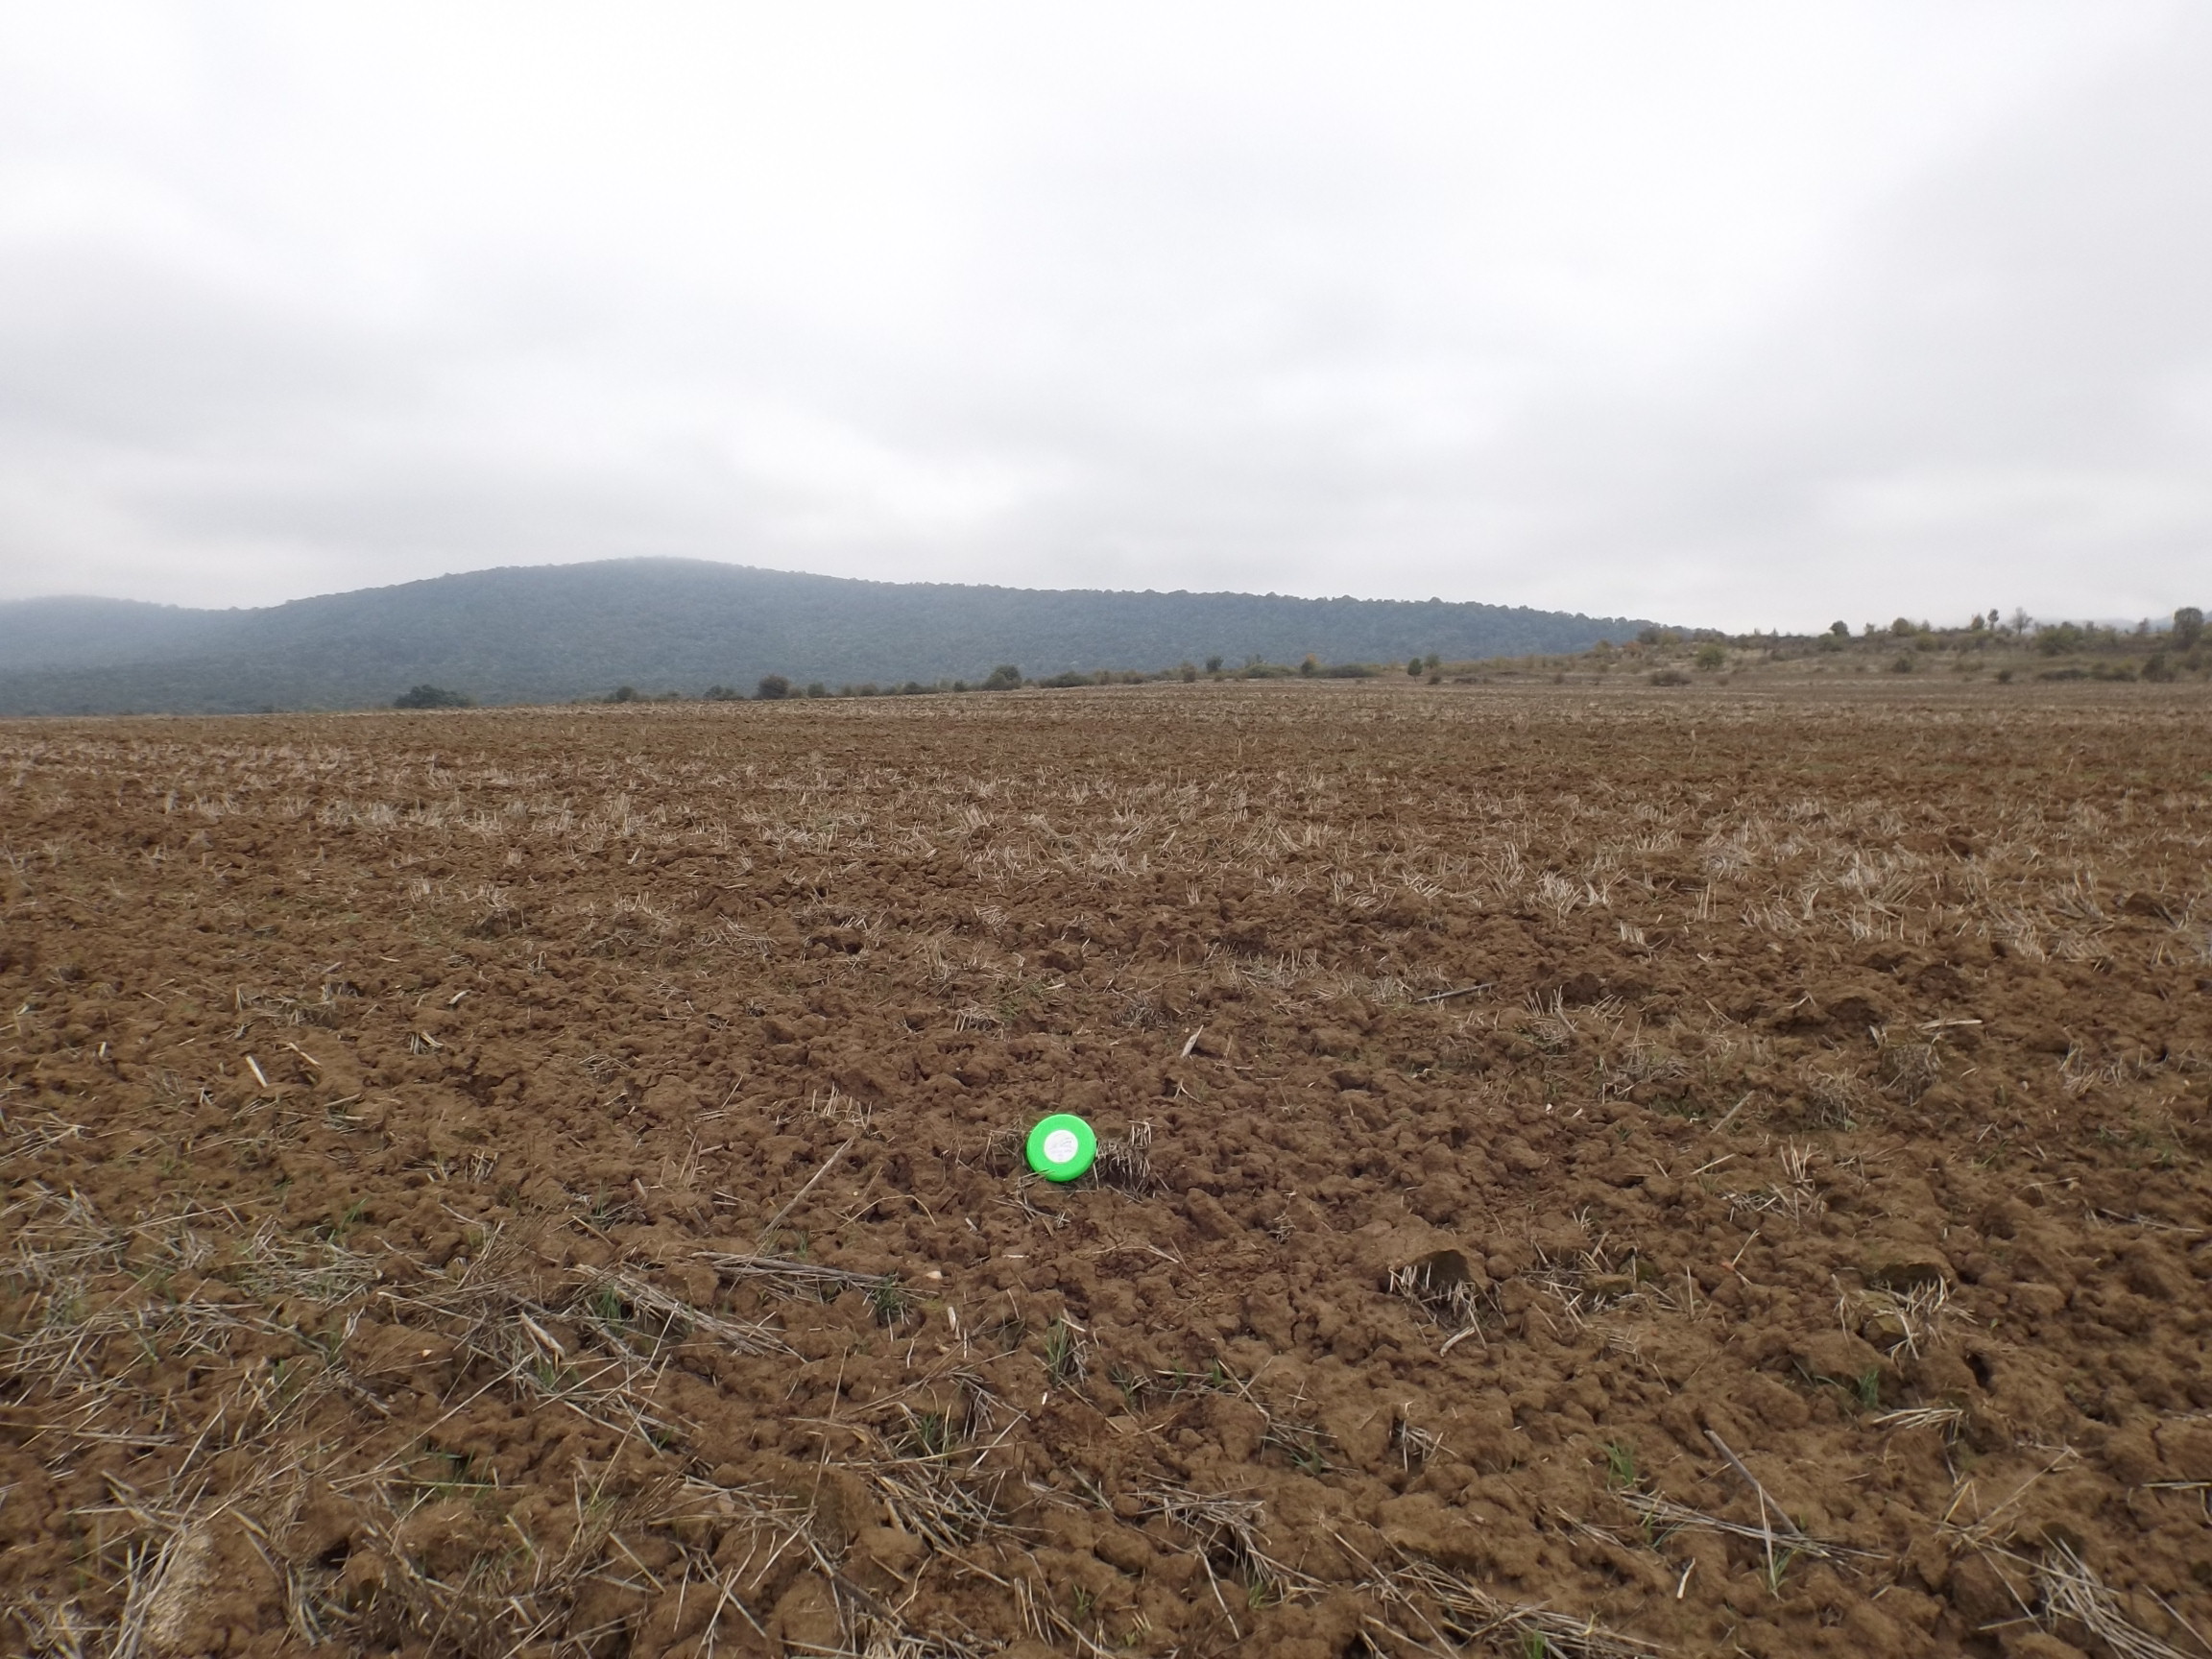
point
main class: Cropland
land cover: Common wheat
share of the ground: < 10 %
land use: Agriculture (excluding fallow land and kitchen gardens)
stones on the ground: < 10 %
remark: Harvested field
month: October
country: BG
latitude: 42.9835
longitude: 27.1488
